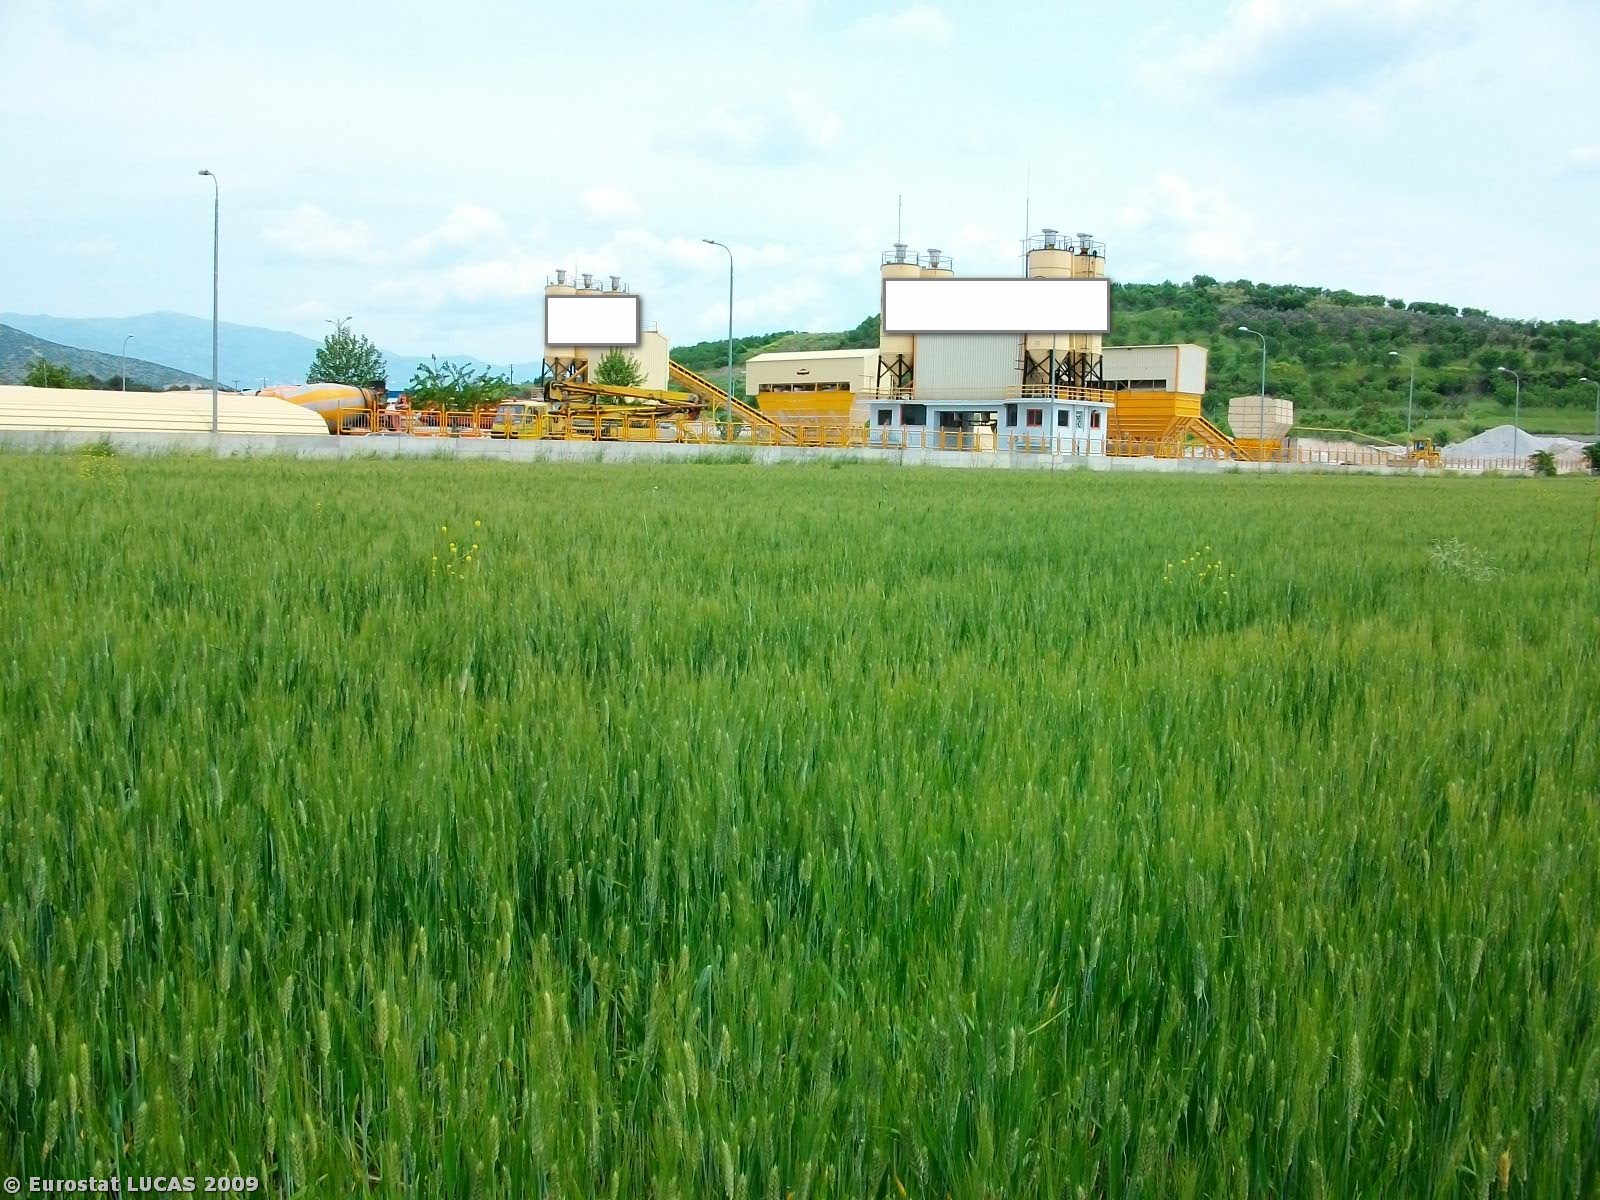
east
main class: Cropland
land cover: Durum wheat
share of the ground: > 75 %
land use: Agriculture (excluding fallow land and kitchen gardens)
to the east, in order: Durum wheat; Artificial constructions; Artificial constructions in urban areas; Artificial constructions; Shrubland without tree cover; Artificial constructions in urban areas
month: May
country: GR
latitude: 39.3829
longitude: 22.8424
